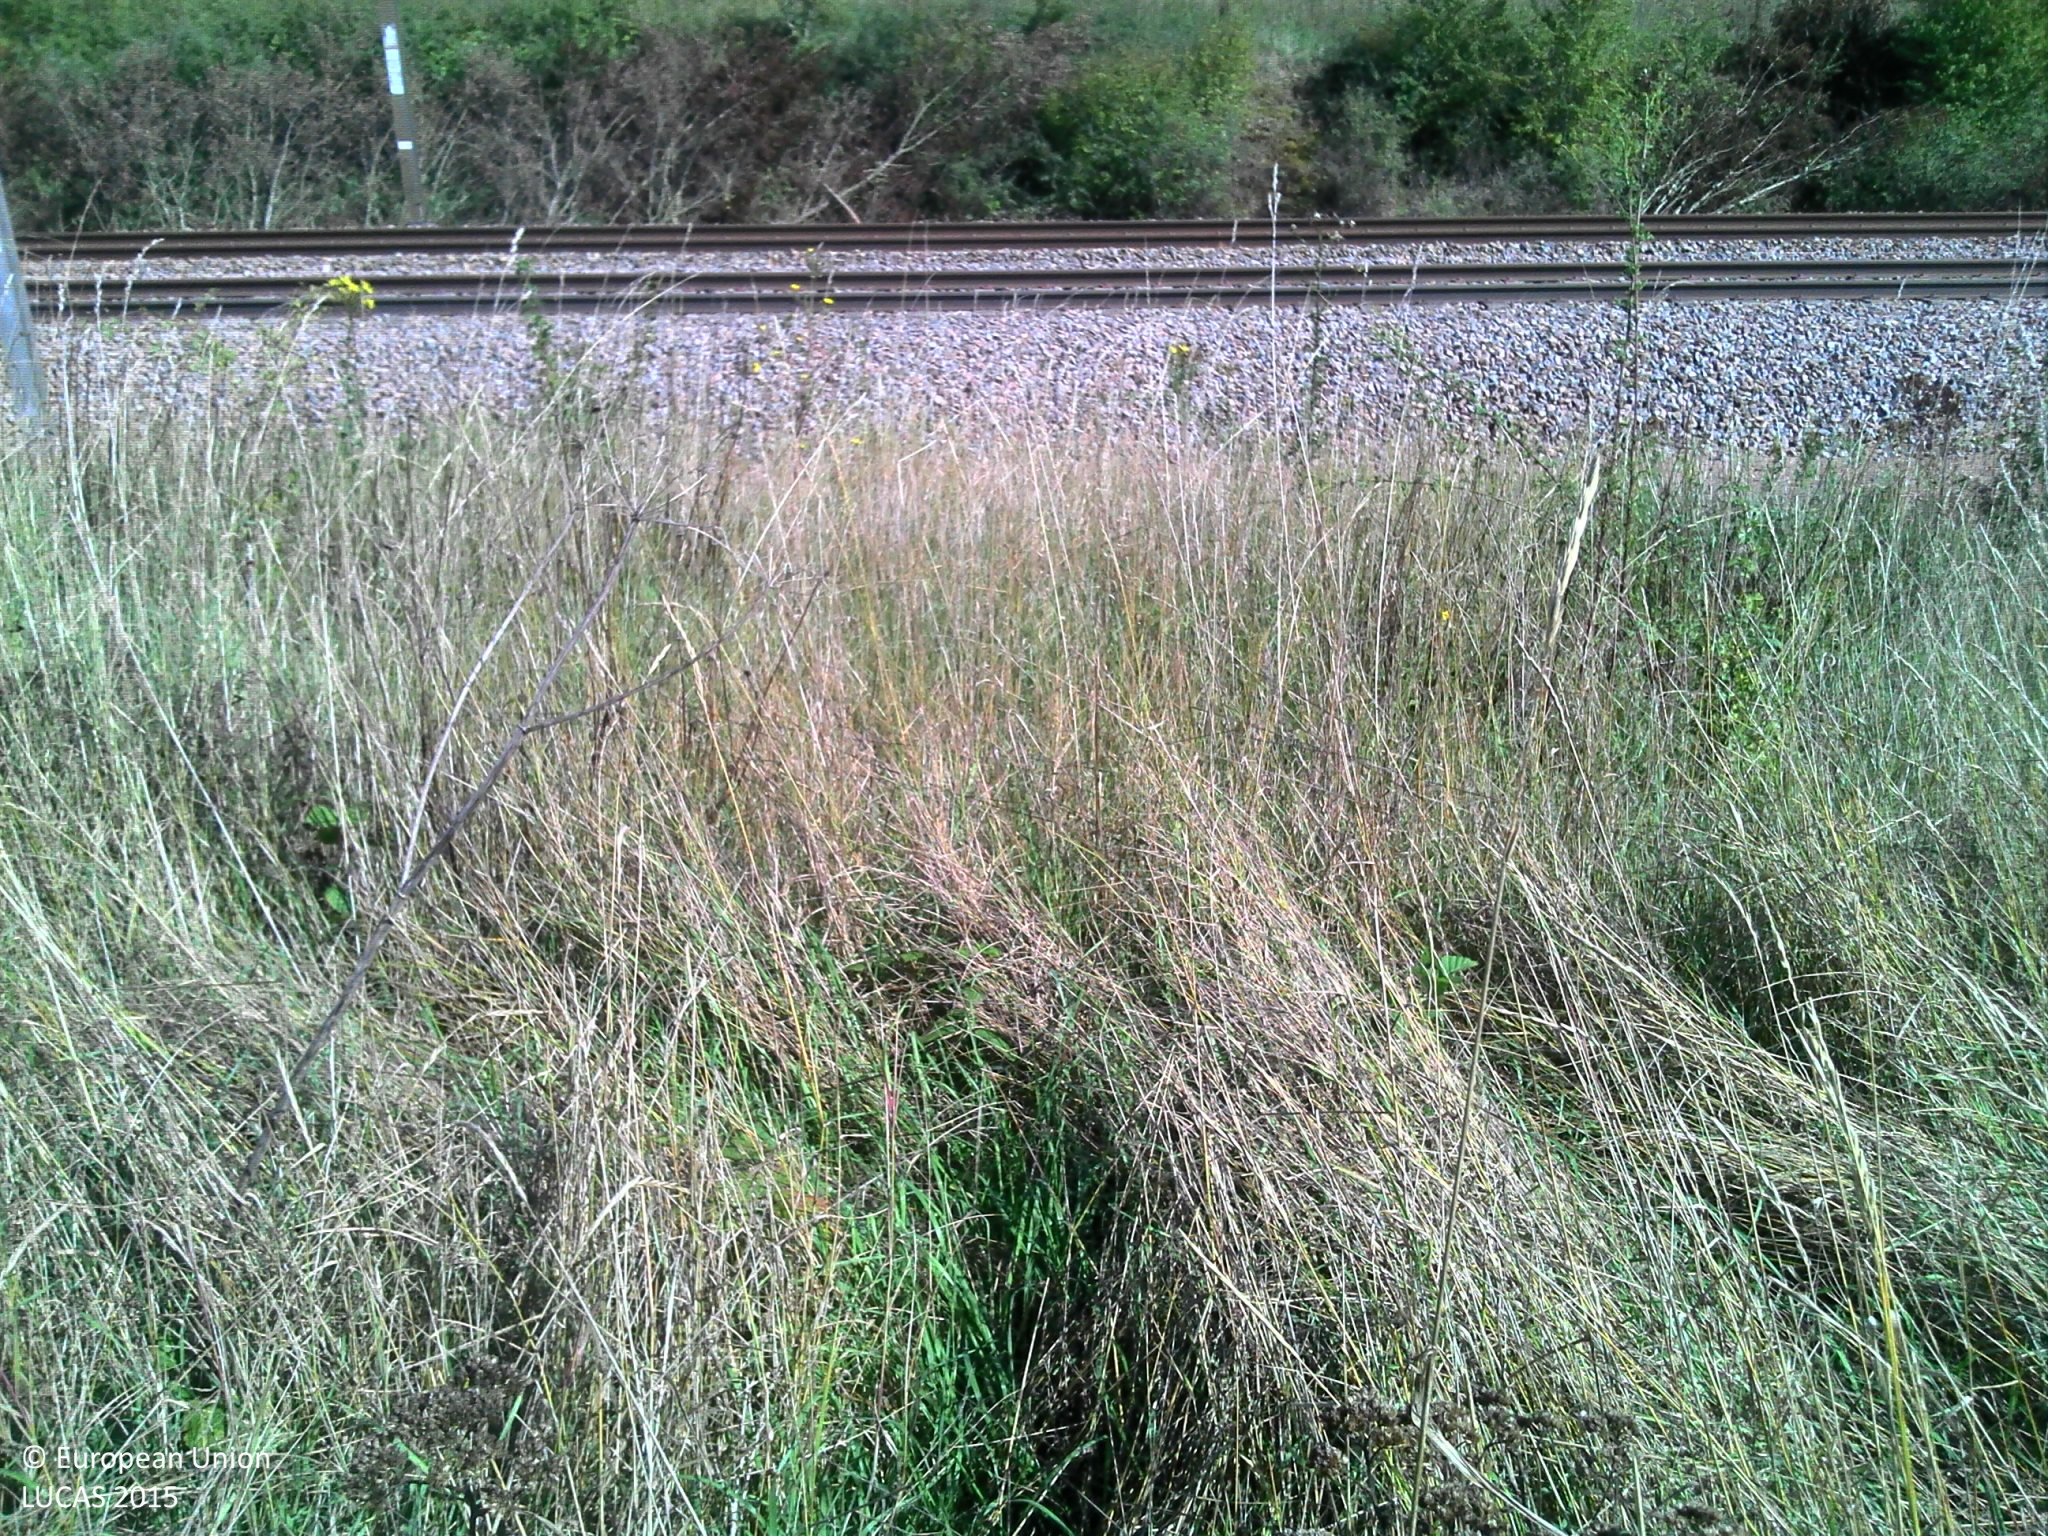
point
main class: Grassland
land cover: Grassland without tree/shrub cover
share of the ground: > 75 %
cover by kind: herbaceous plants 100 %
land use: Railway transport
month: September
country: FR
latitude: 47.2105
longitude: 4.3088
